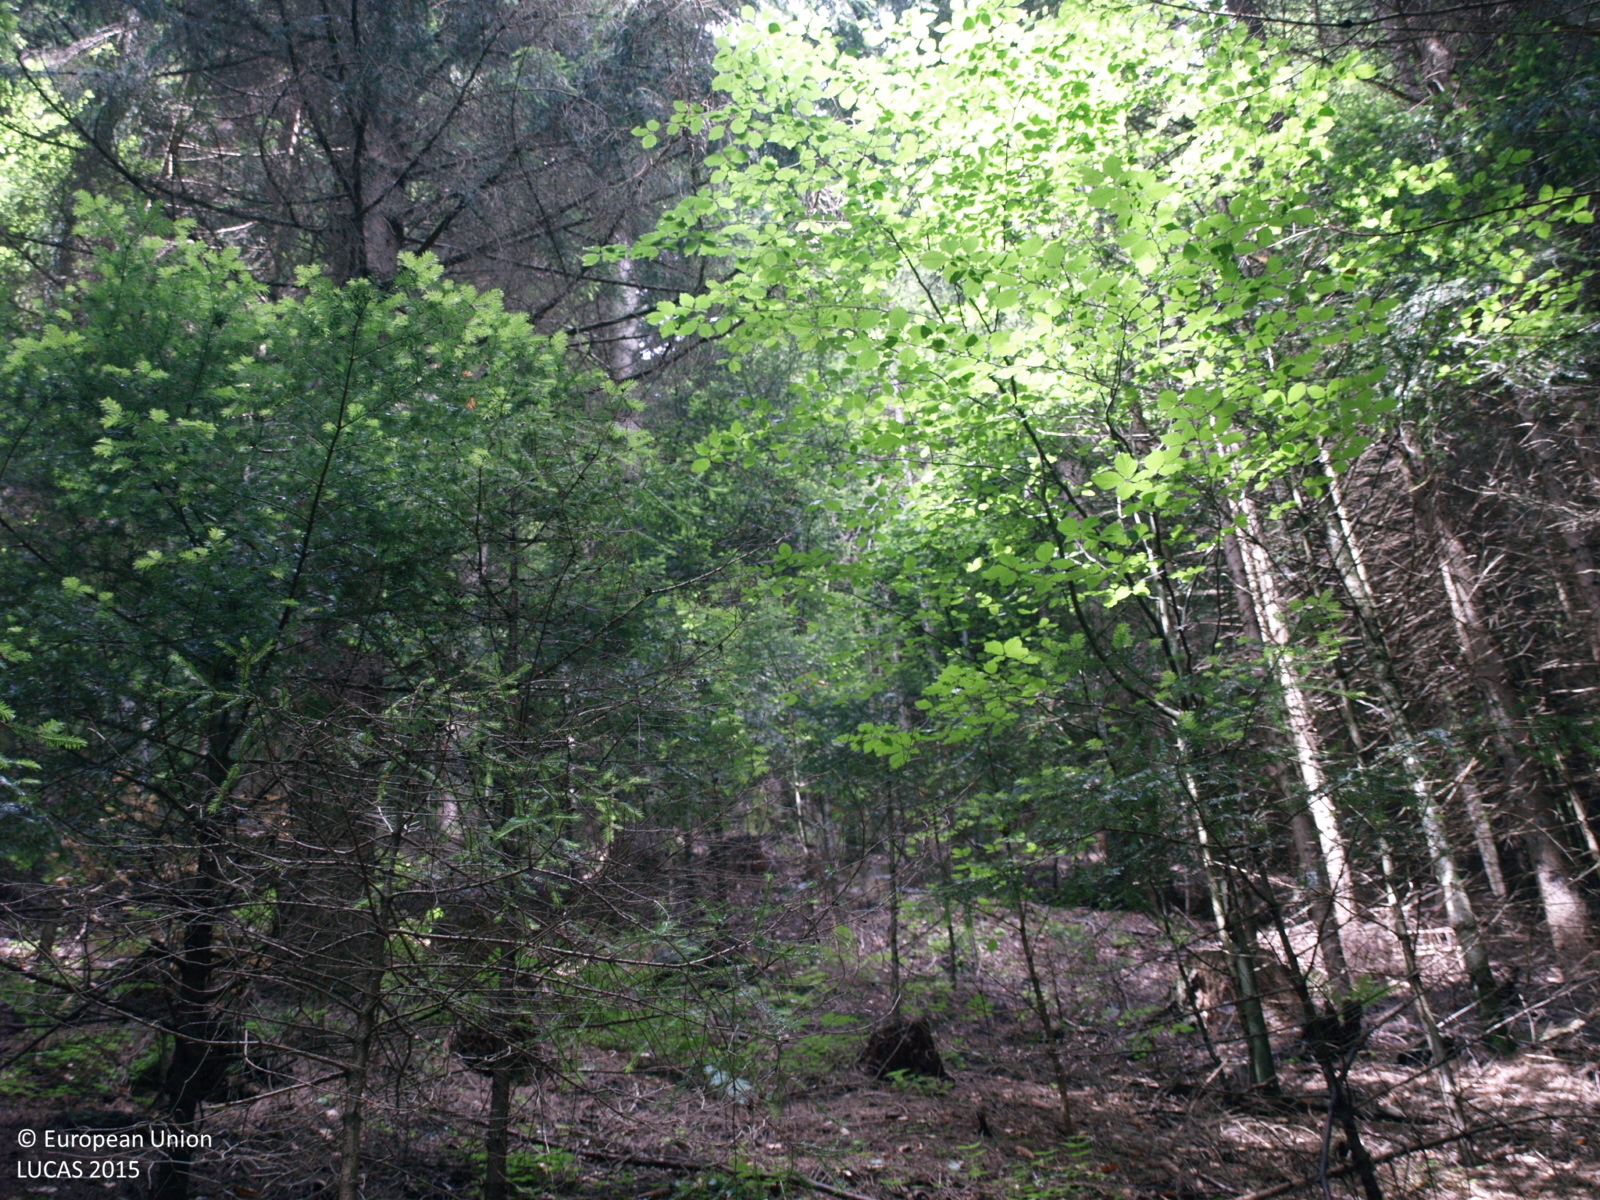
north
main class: Woodland
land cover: Spruce dominated mixed woodland
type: alpine coniferous forest
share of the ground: > 75 %
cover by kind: coniferous forest trees 75 %, broadleaved forest trees 25 %
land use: Forestry
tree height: > 5 m
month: May
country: IT
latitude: 46.2125
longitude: 11.6440
